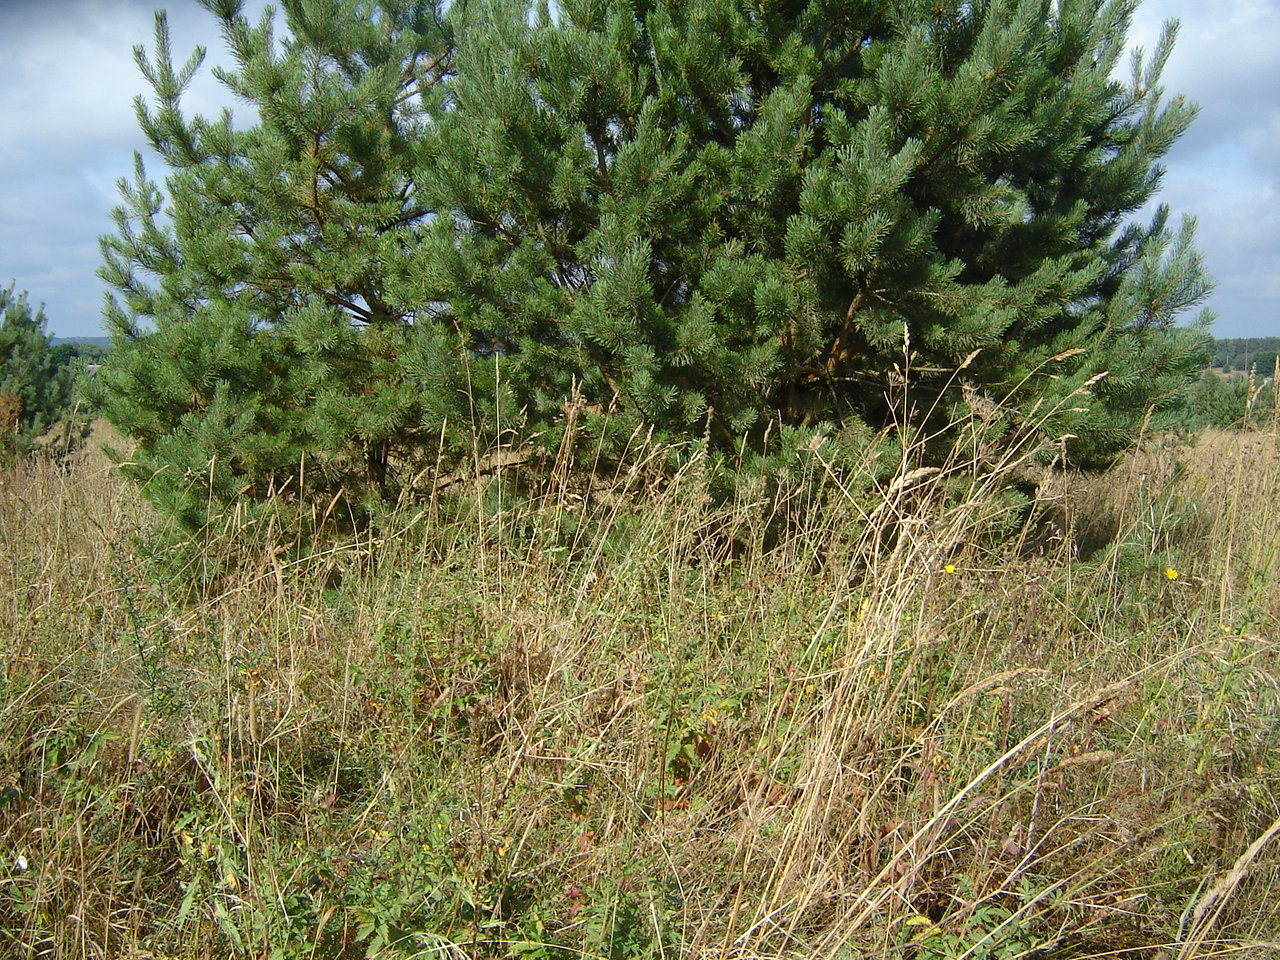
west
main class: Grassland
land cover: Grassland with sparse tree/shrub cover
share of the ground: > 75 %
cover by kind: herbaceous plants 90 %, coniferous forest trees 5 %, shrubs 5 %
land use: Fallow land
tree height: > 5 m
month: August
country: LT
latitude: 54.7280
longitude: 24.7194
